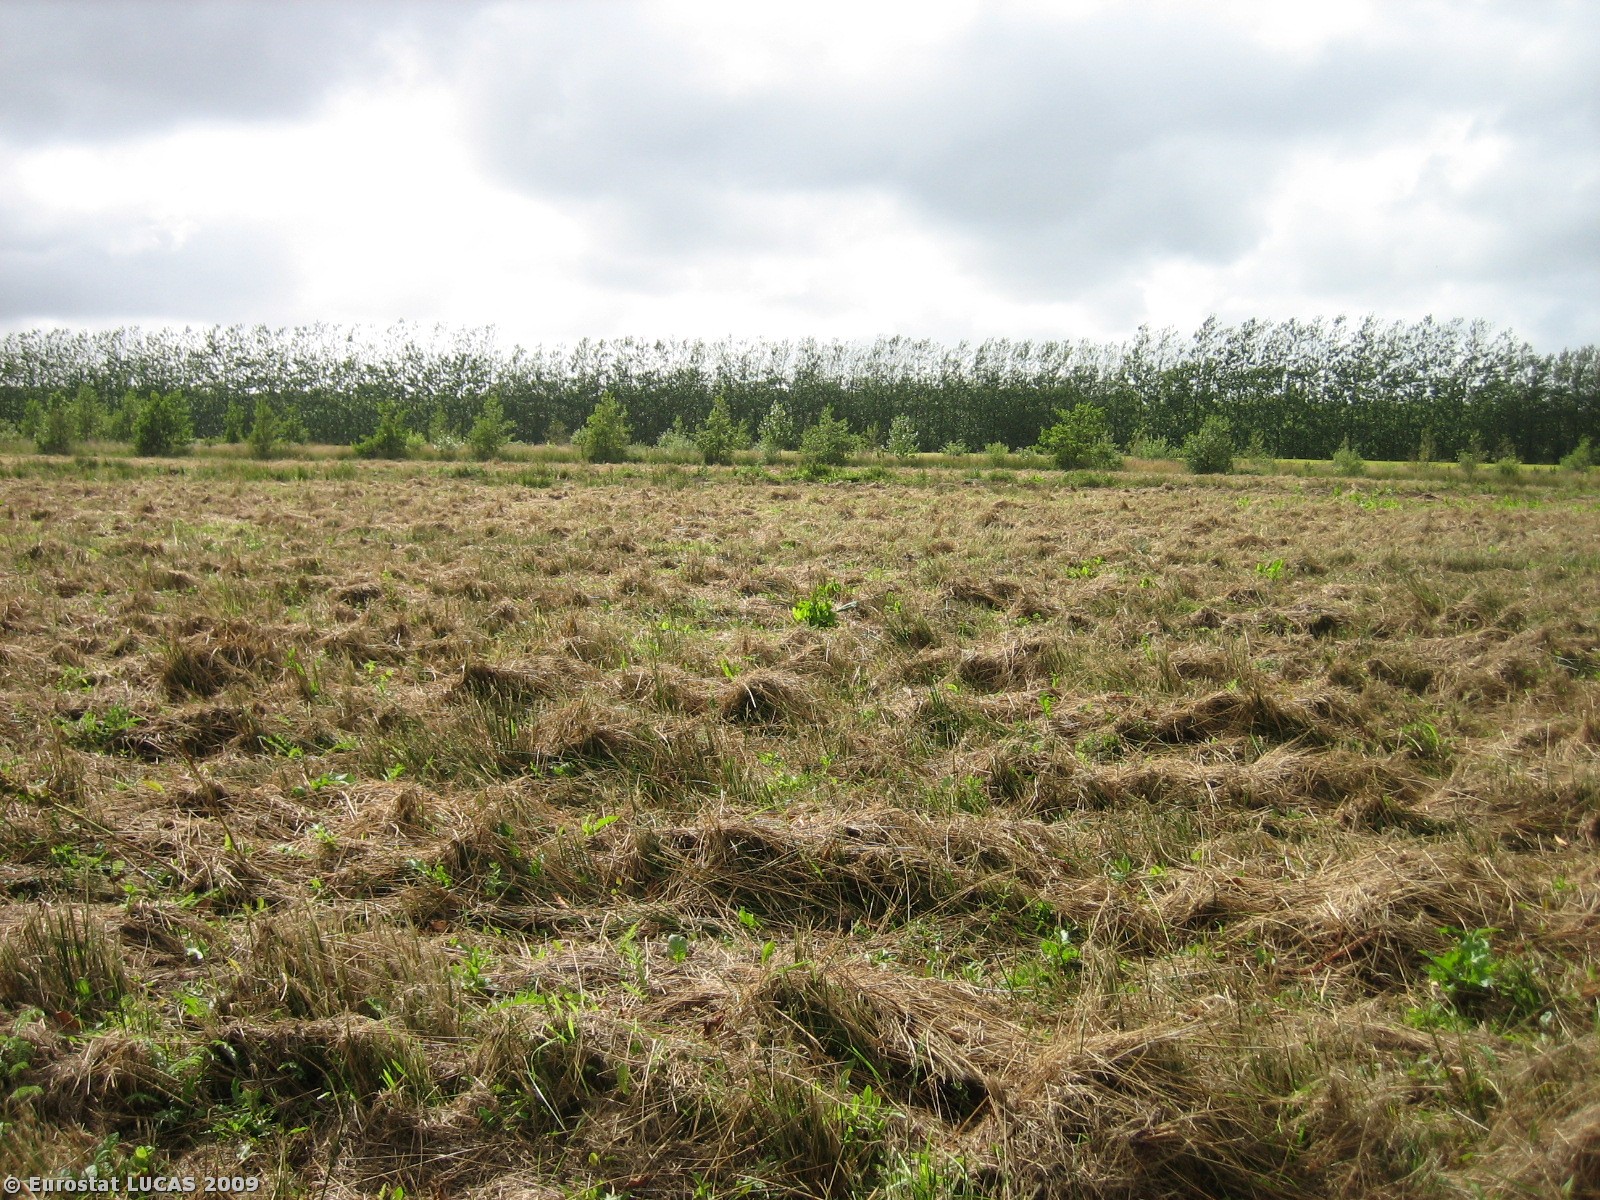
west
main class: Grassland
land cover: Grassland without tree/shrub cover
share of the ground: > 75 %
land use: Agriculture (excluding fallow land and kitchen gardens)
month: July
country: DK
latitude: 55.6551
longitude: 8.3010
